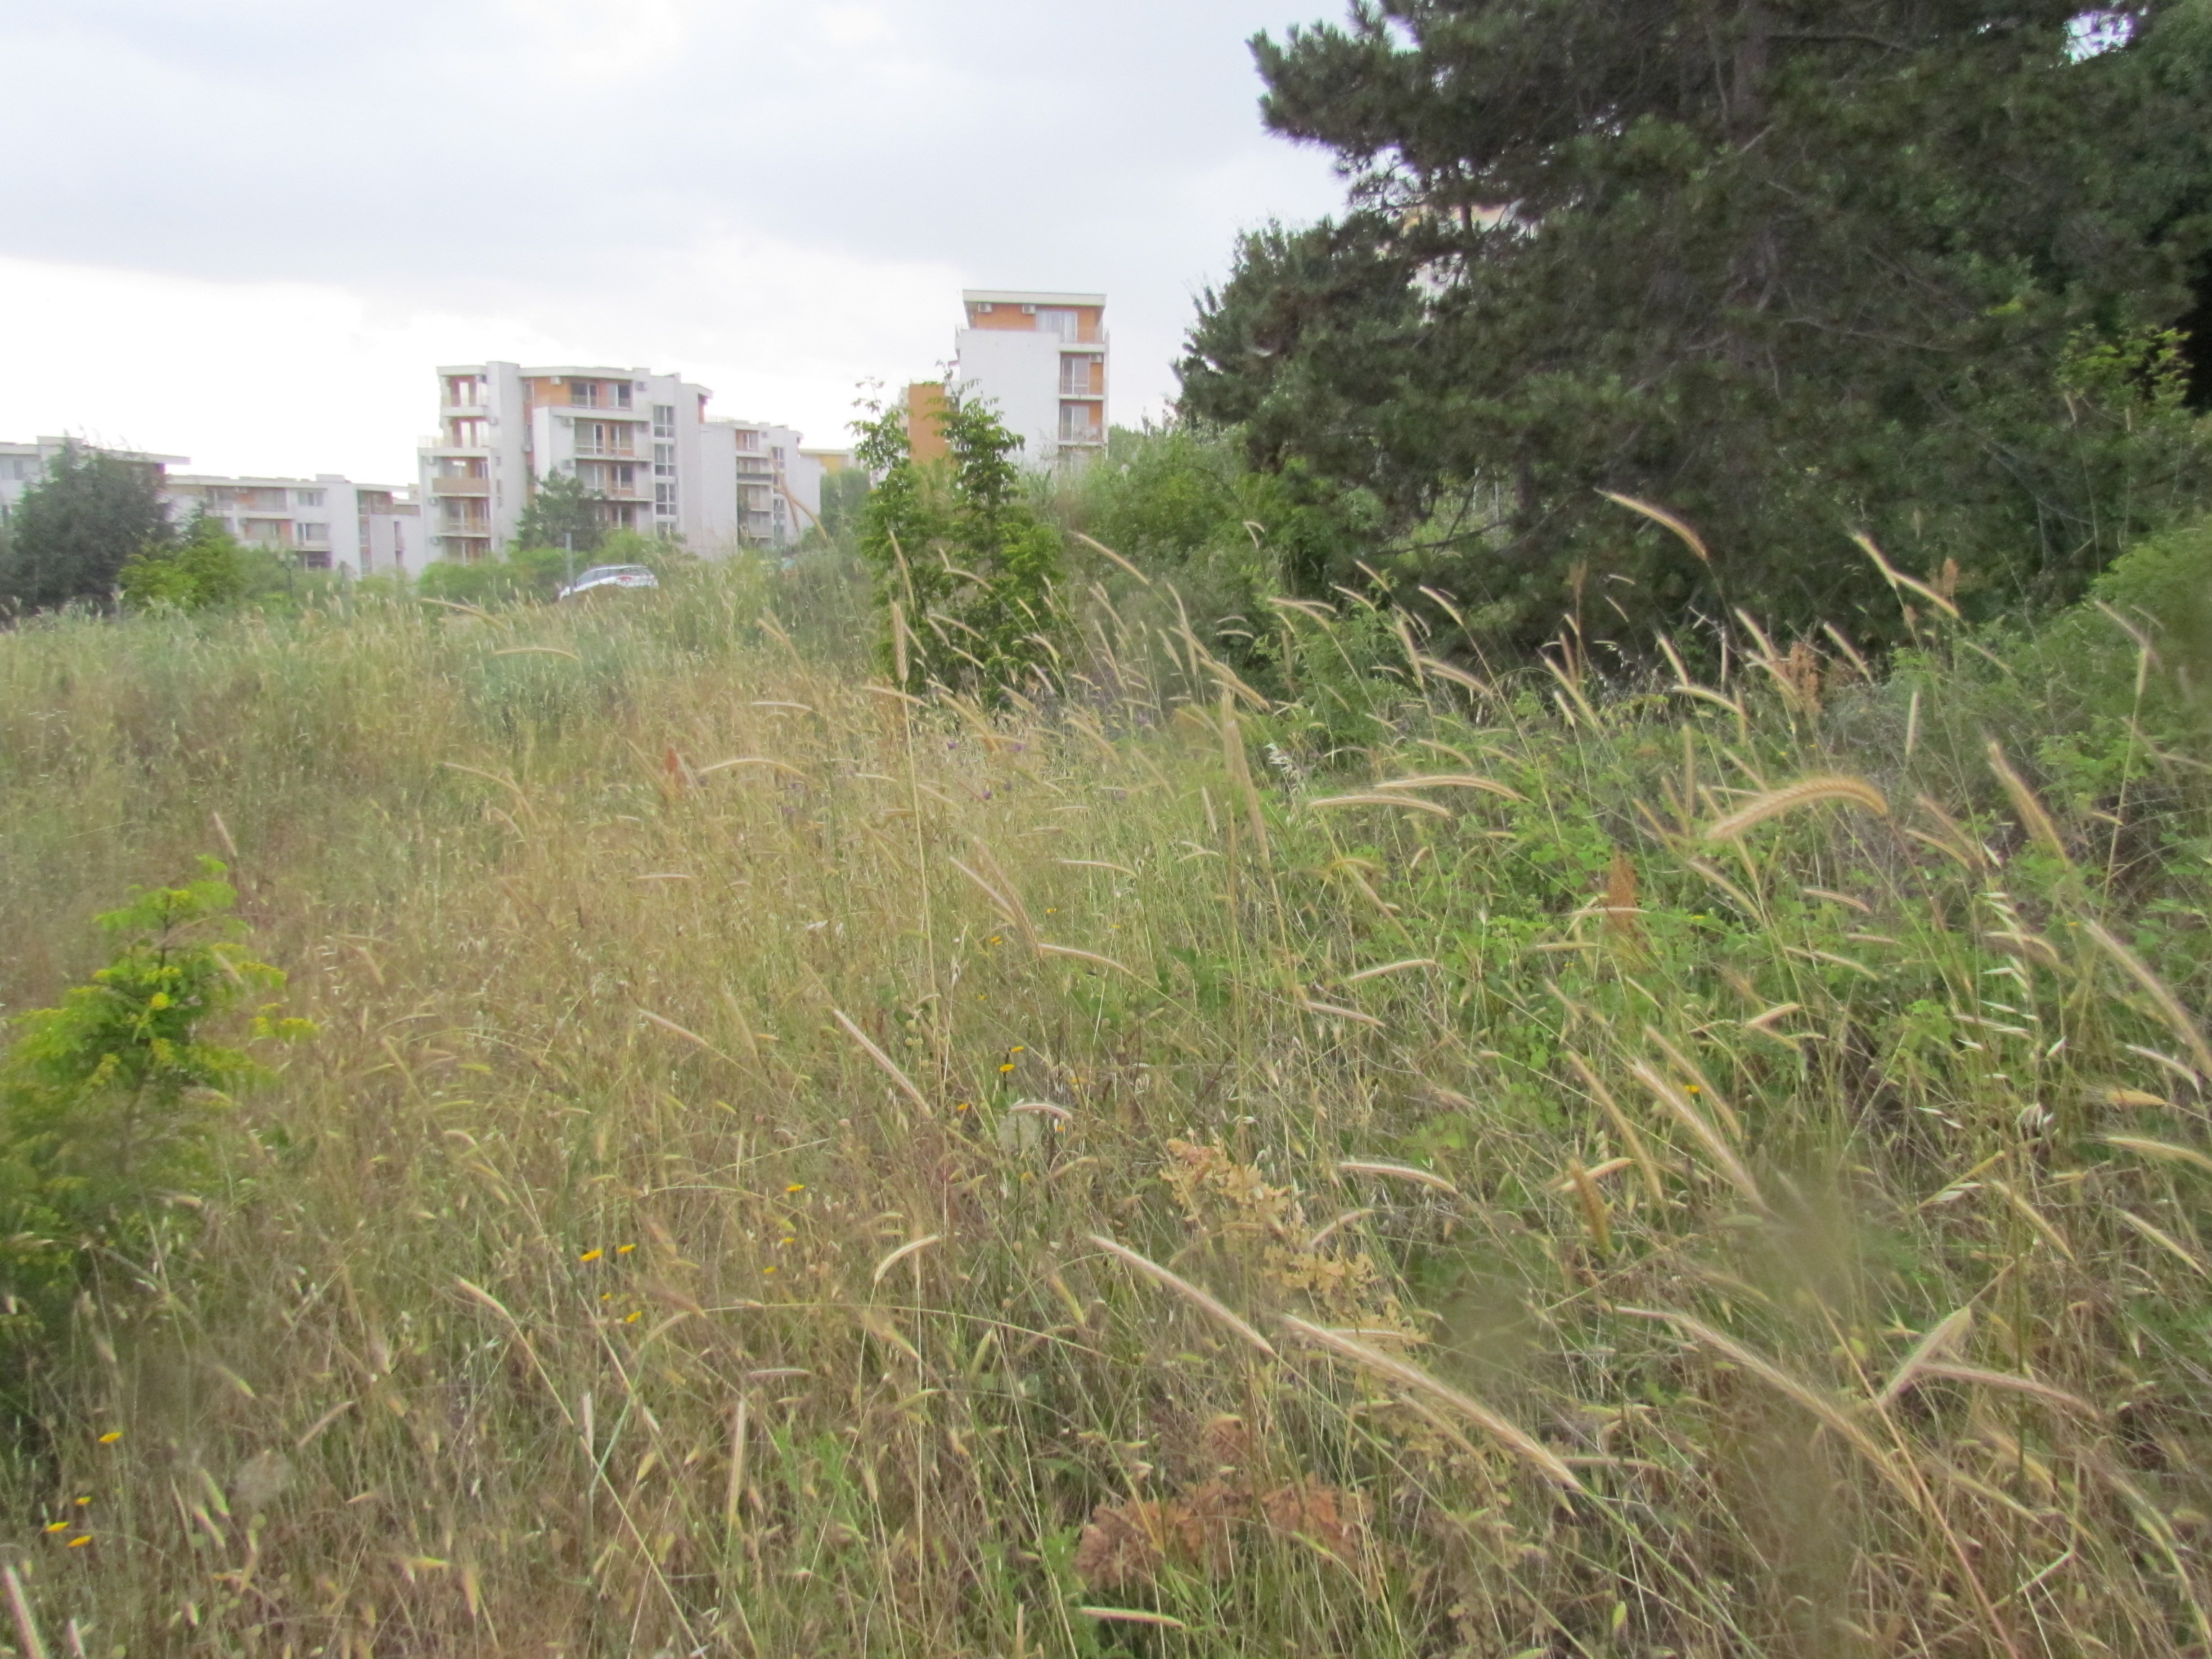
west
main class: Grassland
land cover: Grassland with sparse tree/shrub cover
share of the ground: > 75 %
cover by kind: herbaceous plants 90 %, broadleaved forest trees 5 %, shrubs 5 %
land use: Semi-natural and natural areas not in use
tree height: > 5 m
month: June
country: BG
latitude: 42.7050
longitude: 27.7946
